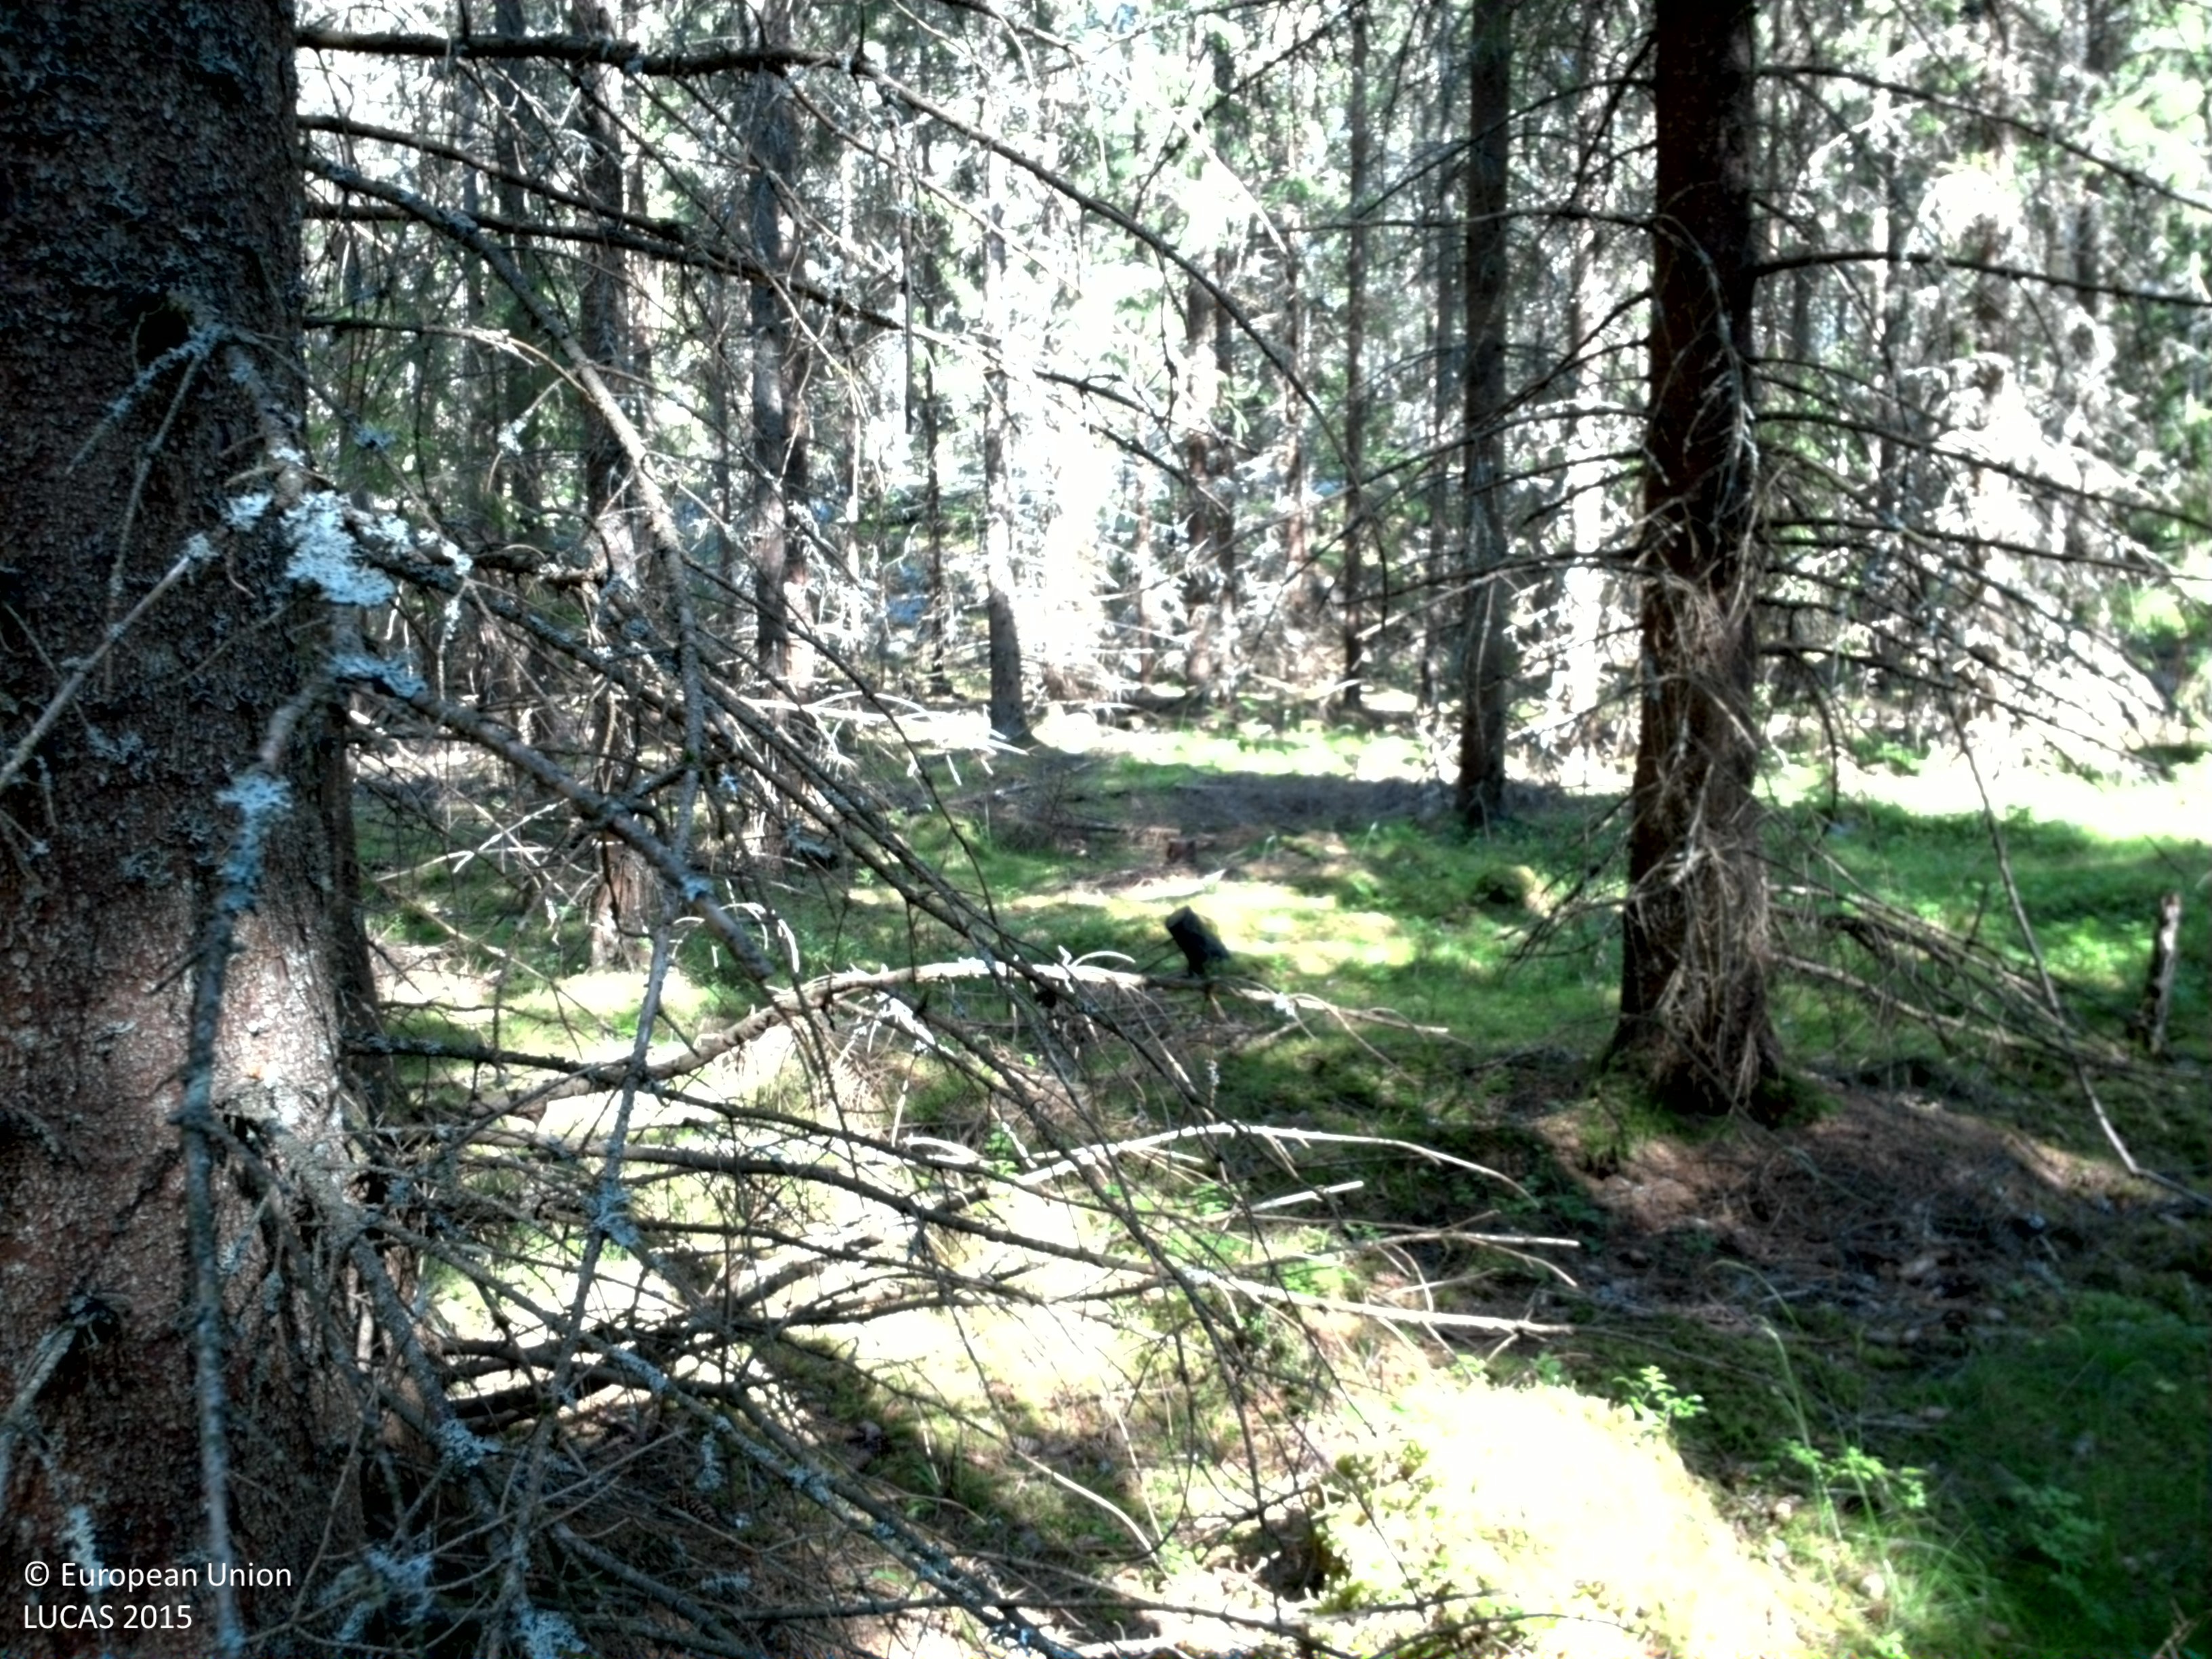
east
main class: Woodland
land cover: Spruce dominated coniferous woodland
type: boreal forest
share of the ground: 25 - 50 %
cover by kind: coniferous forest trees 40 %, lichens and mosses 40 %, herbaceous plants 20 %
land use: Forestry
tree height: > 5 m
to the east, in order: Spruce dominated coniferous woodland; Other coniferous woodland; Pine dominated mixed woodland; Broadleaved woodland; Grass margins; Paved roads, cycling and walking lanes; Grass margins; Ditches and canals; Pine dominated coniferous woodland
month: July
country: SE
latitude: 58.7208
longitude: 14.4999
